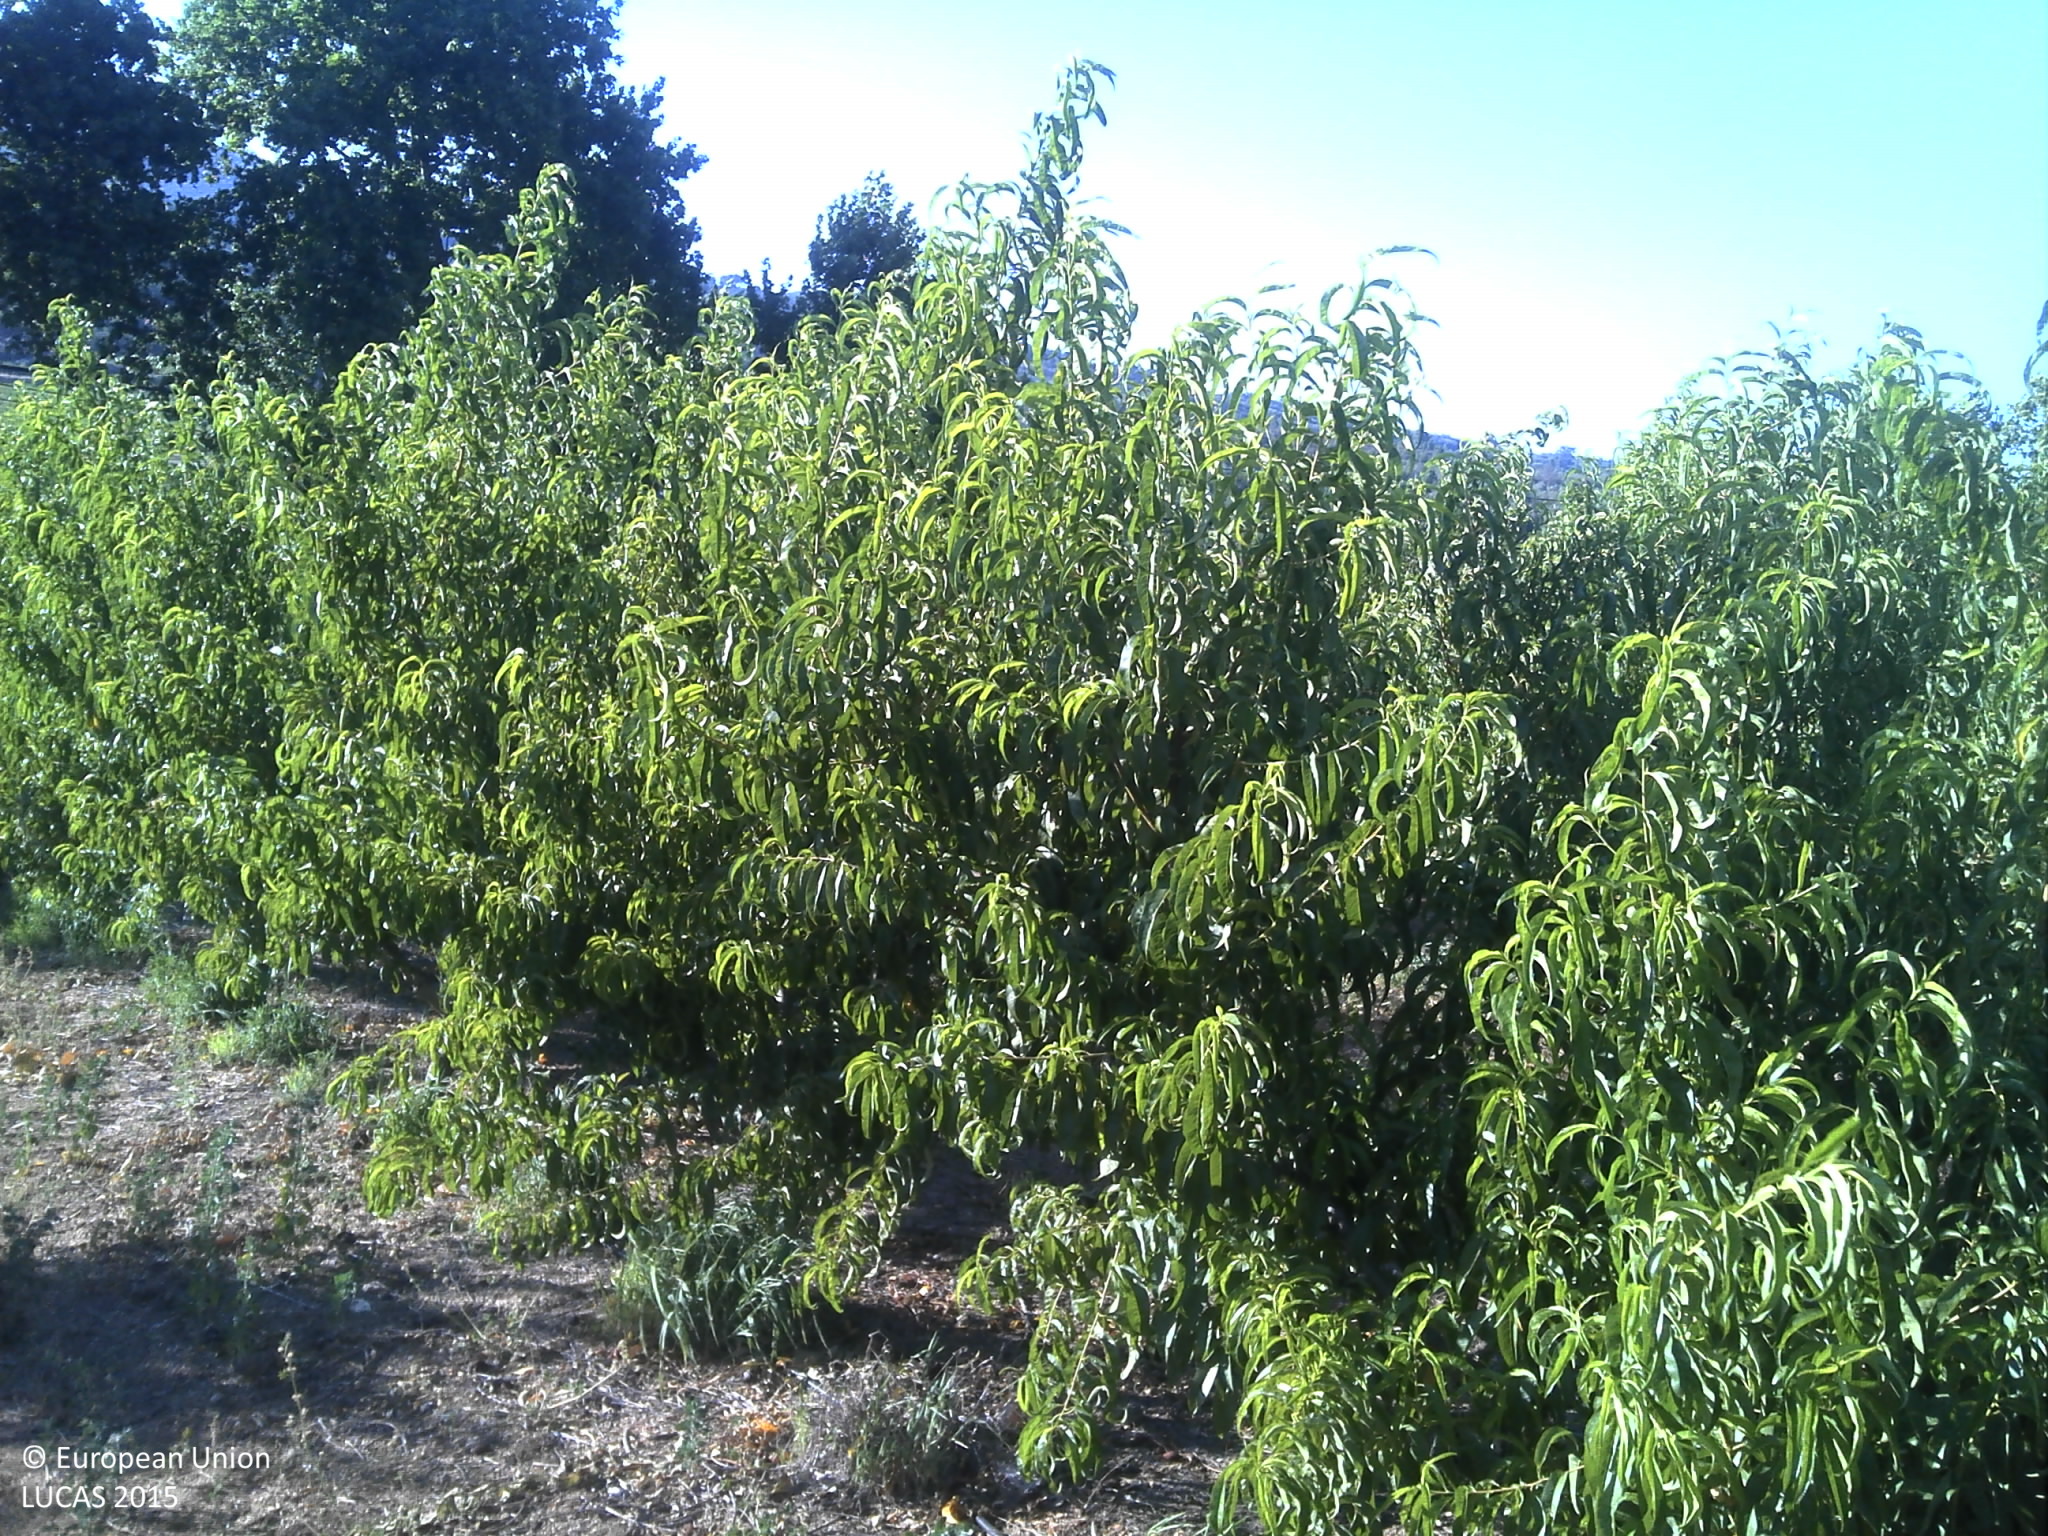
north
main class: Cropland
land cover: Other fruit trees and berries
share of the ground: 50 - 75 %
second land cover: Spontaneously vegetated surfaces
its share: 10 - 25 %
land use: Agriculture (excluding fallow land and kitchen gardens)
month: July
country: PT
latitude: 40.3415
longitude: -7.3990
